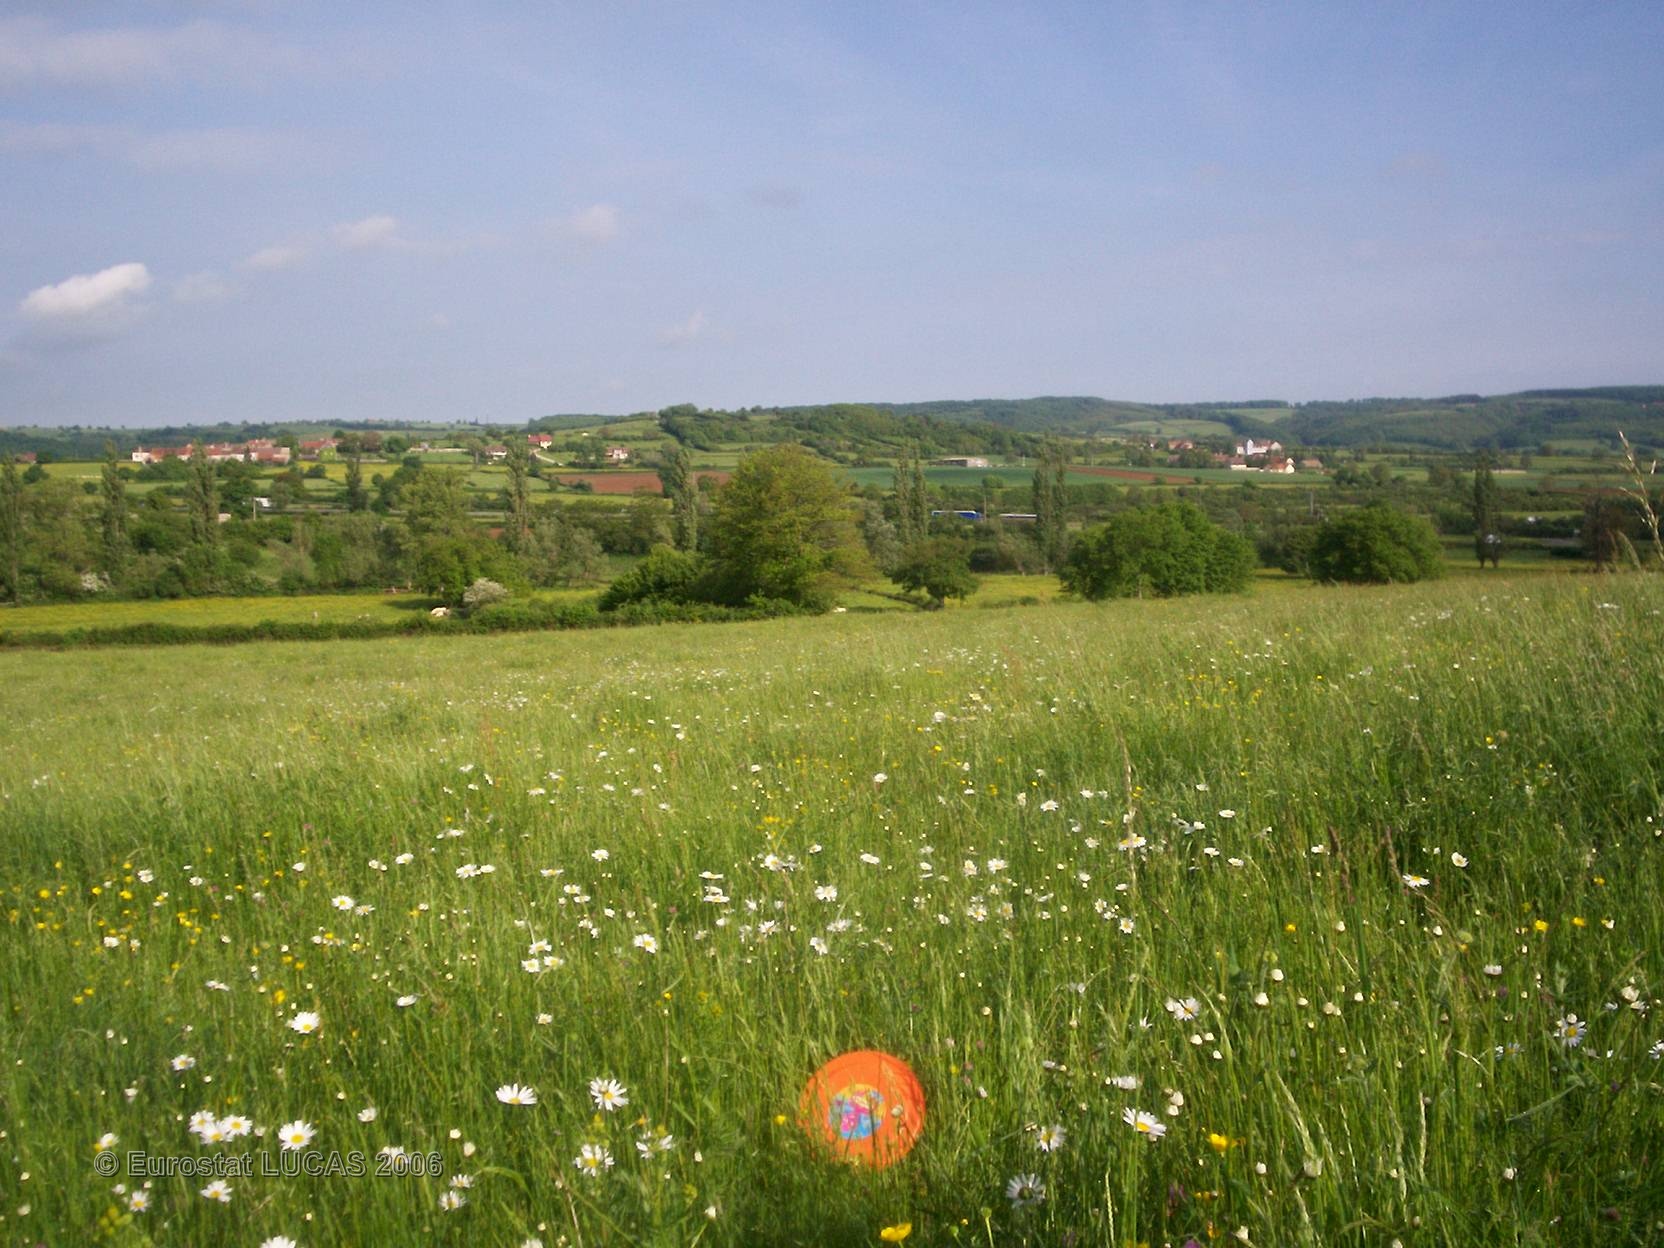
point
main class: Grassland
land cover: Grassland without tree/shrub cover
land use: Agriculture (excluding fallow land and kitchen gardens)
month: May
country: FR
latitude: 46.7406
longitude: 4.6480
